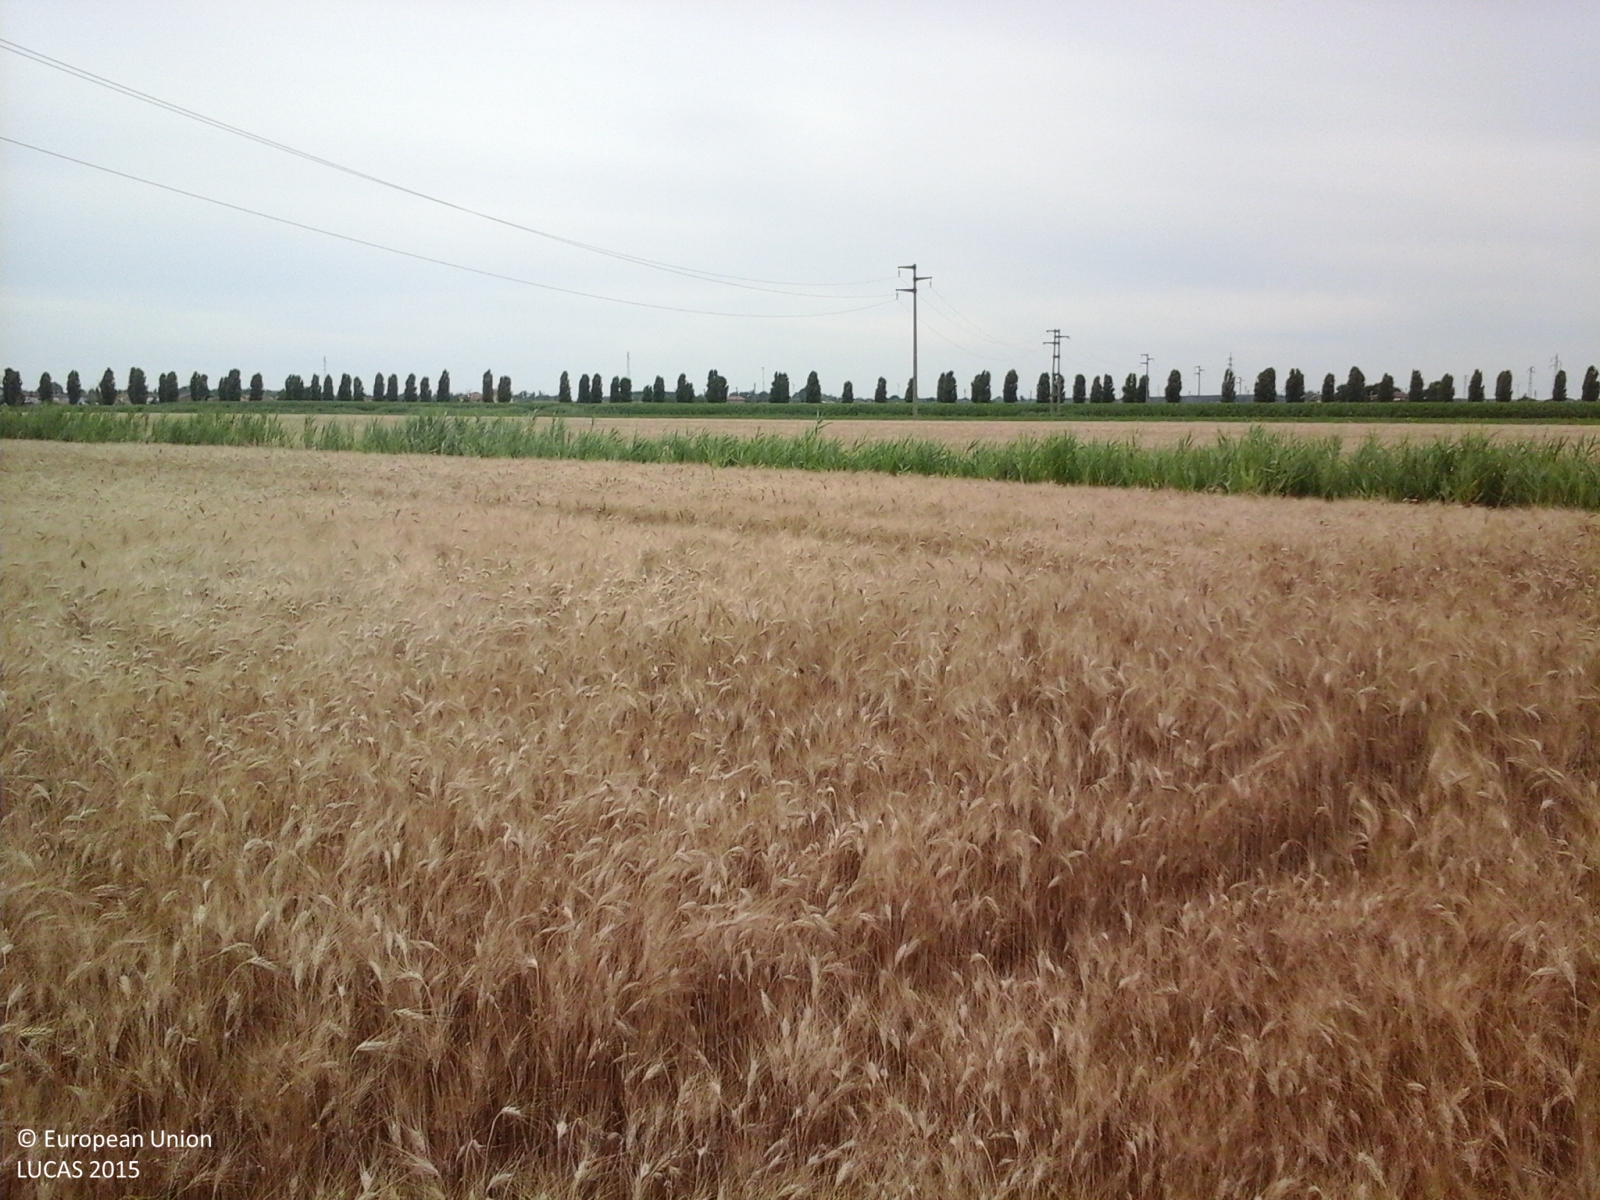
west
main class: Cropland
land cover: Common wheat
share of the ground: > 75 %
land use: Agriculture (excluding fallow land and kitchen gardens)
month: June
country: IT
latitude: 44.9375
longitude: 12.3401
